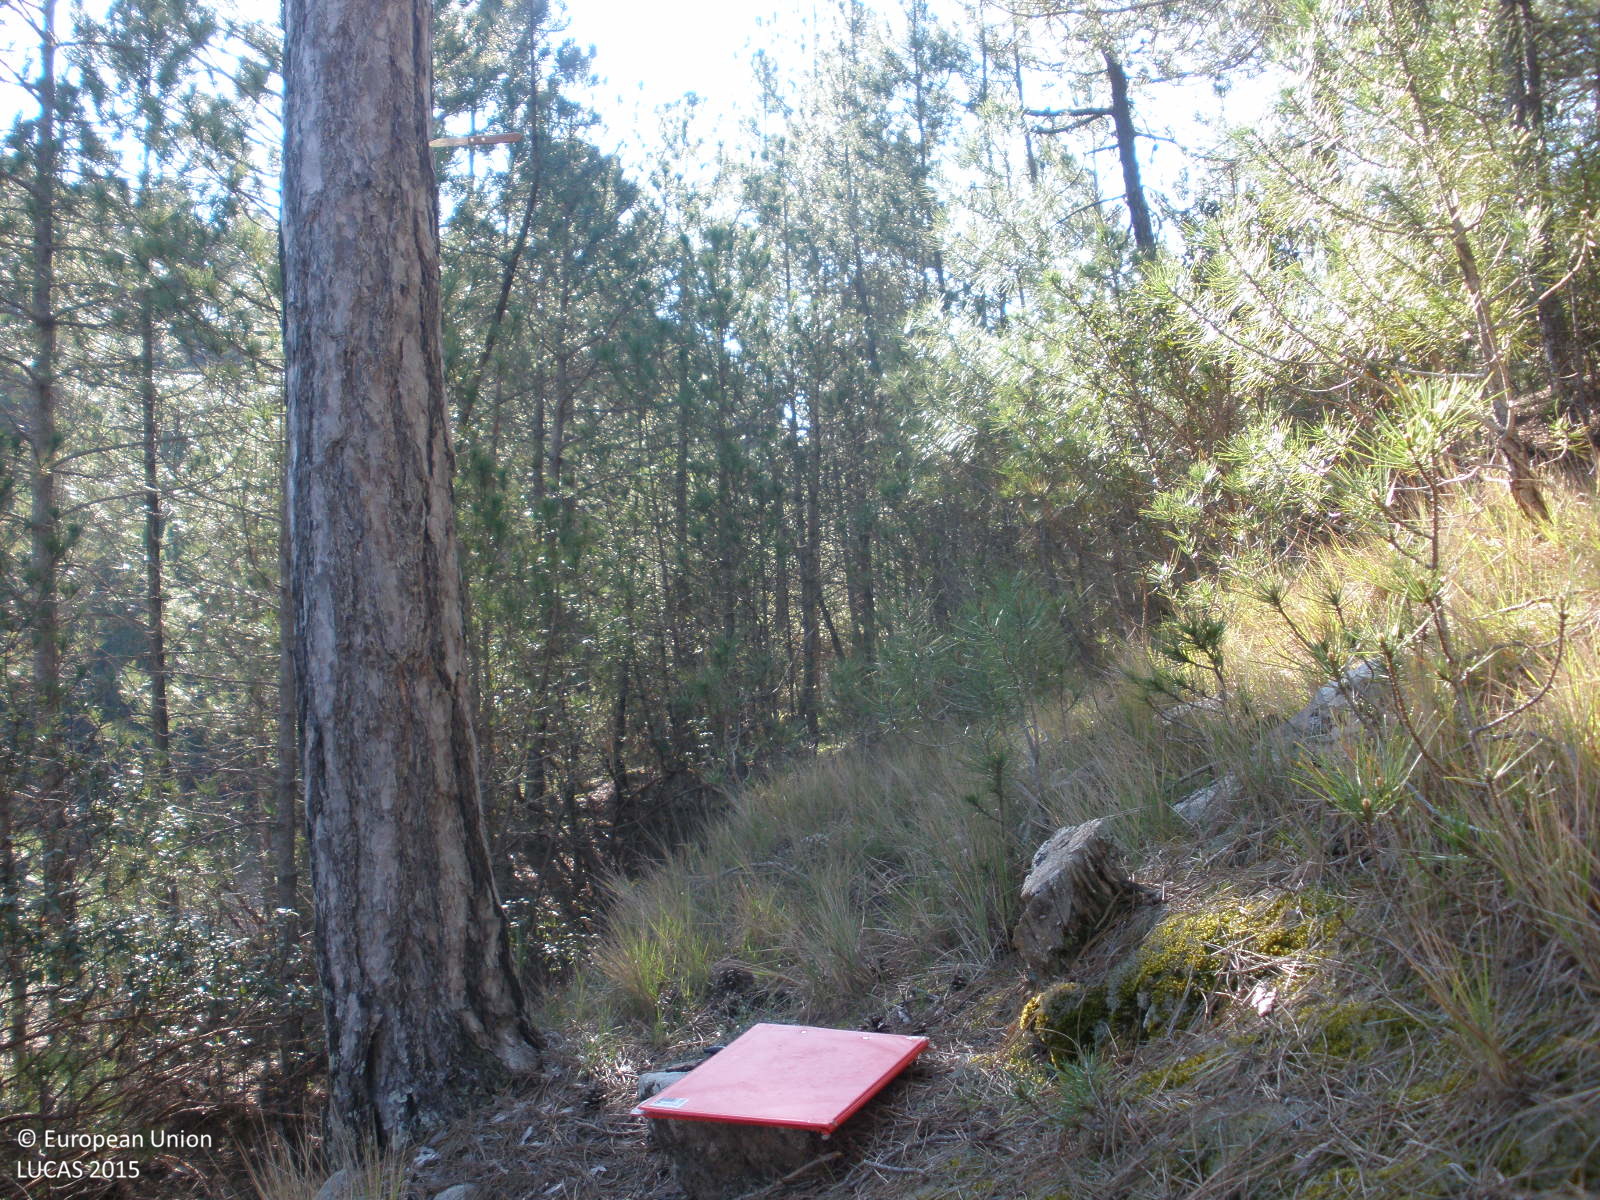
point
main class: Woodland
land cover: Pine dominated coniferous woodland
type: coniferous forest of the mediterranean region
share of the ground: > 75 %
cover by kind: coniferous forest trees 75 %, shrubs 15 %, herbaceous plants 10 %
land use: Forestry
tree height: > 5 m
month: April
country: ES
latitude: 40.2900
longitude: -0.7948
